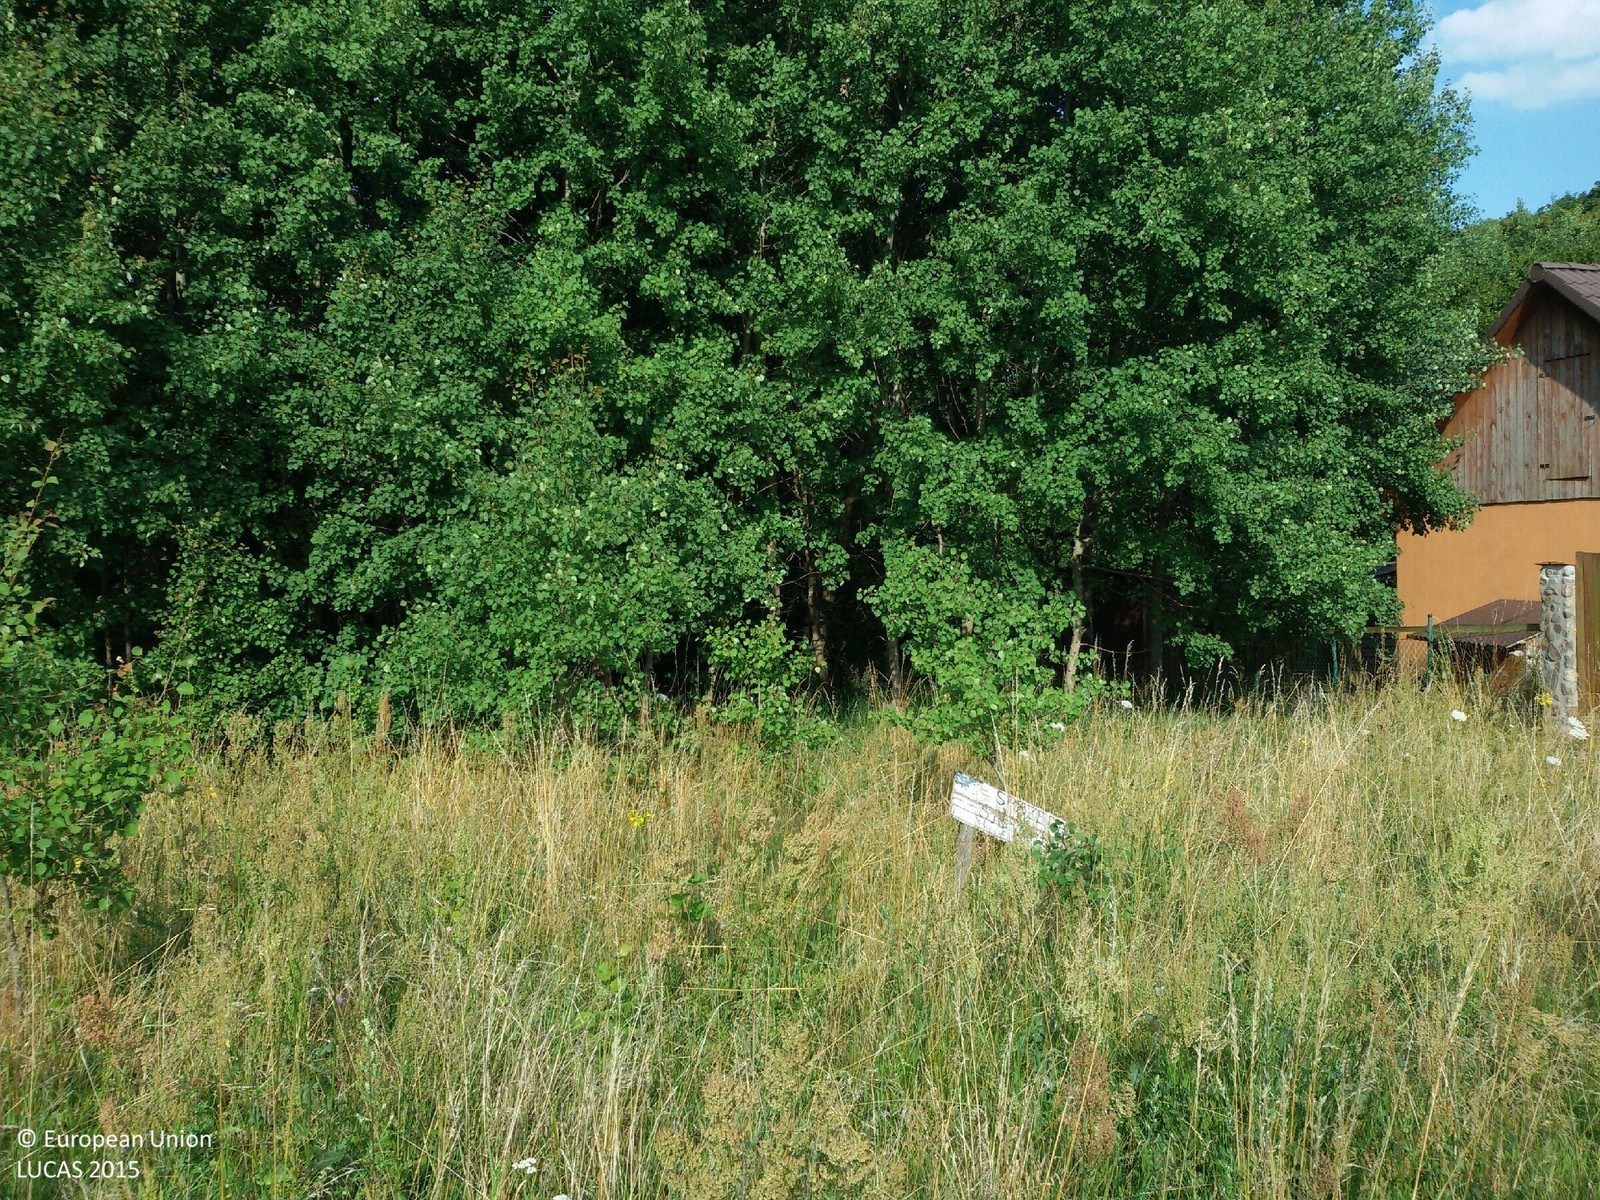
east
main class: Grassland
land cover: Spontaneously vegetated surfaces
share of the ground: > 75 %
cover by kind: herbaceous plants 100 %
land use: Construction
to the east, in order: Spontaneously vegetated surfaces; Broadleaved woodland; Rivers and streams; Broadleaved woodland; Artificial constructions in urban areas
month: July
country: PL
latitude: 53.2118
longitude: 15.7393
